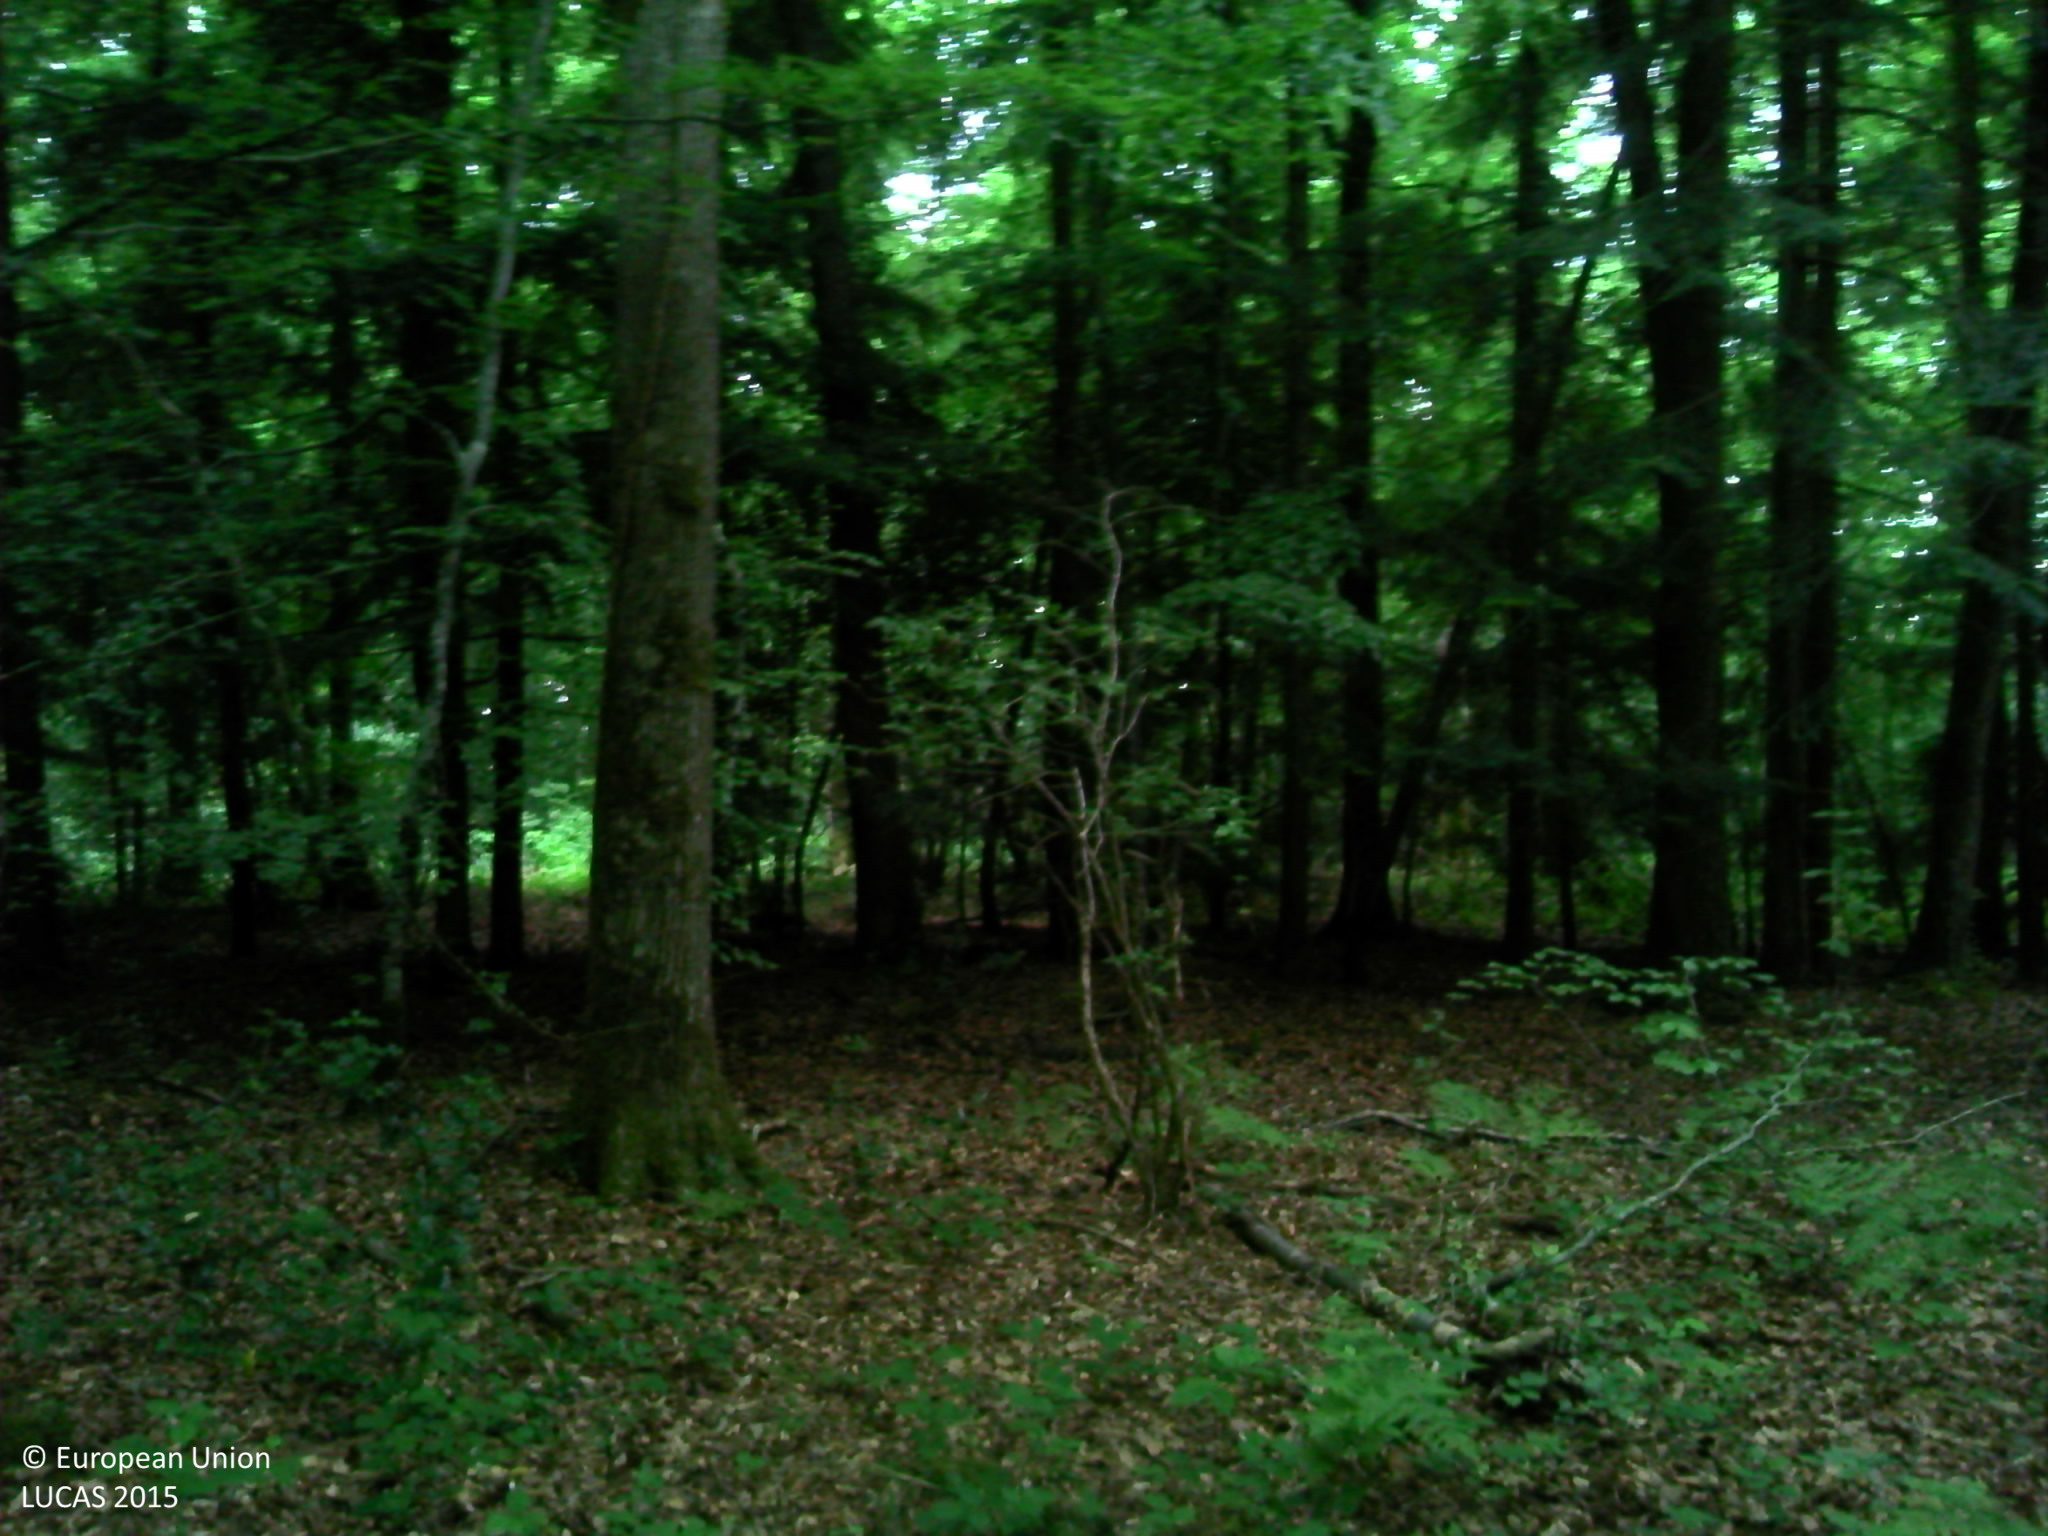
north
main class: Woodland
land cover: Broadleaved woodland
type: acidophilous oak and oak-birch forest
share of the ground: > 75 %
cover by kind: broadleaved forest trees 75 %, coniferous forest trees 10 %, herbaceous plants 10 %, shrubs 5 %
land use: Forestry
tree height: > 5 m
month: July
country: FR
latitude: 48.9345
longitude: 0.0732
